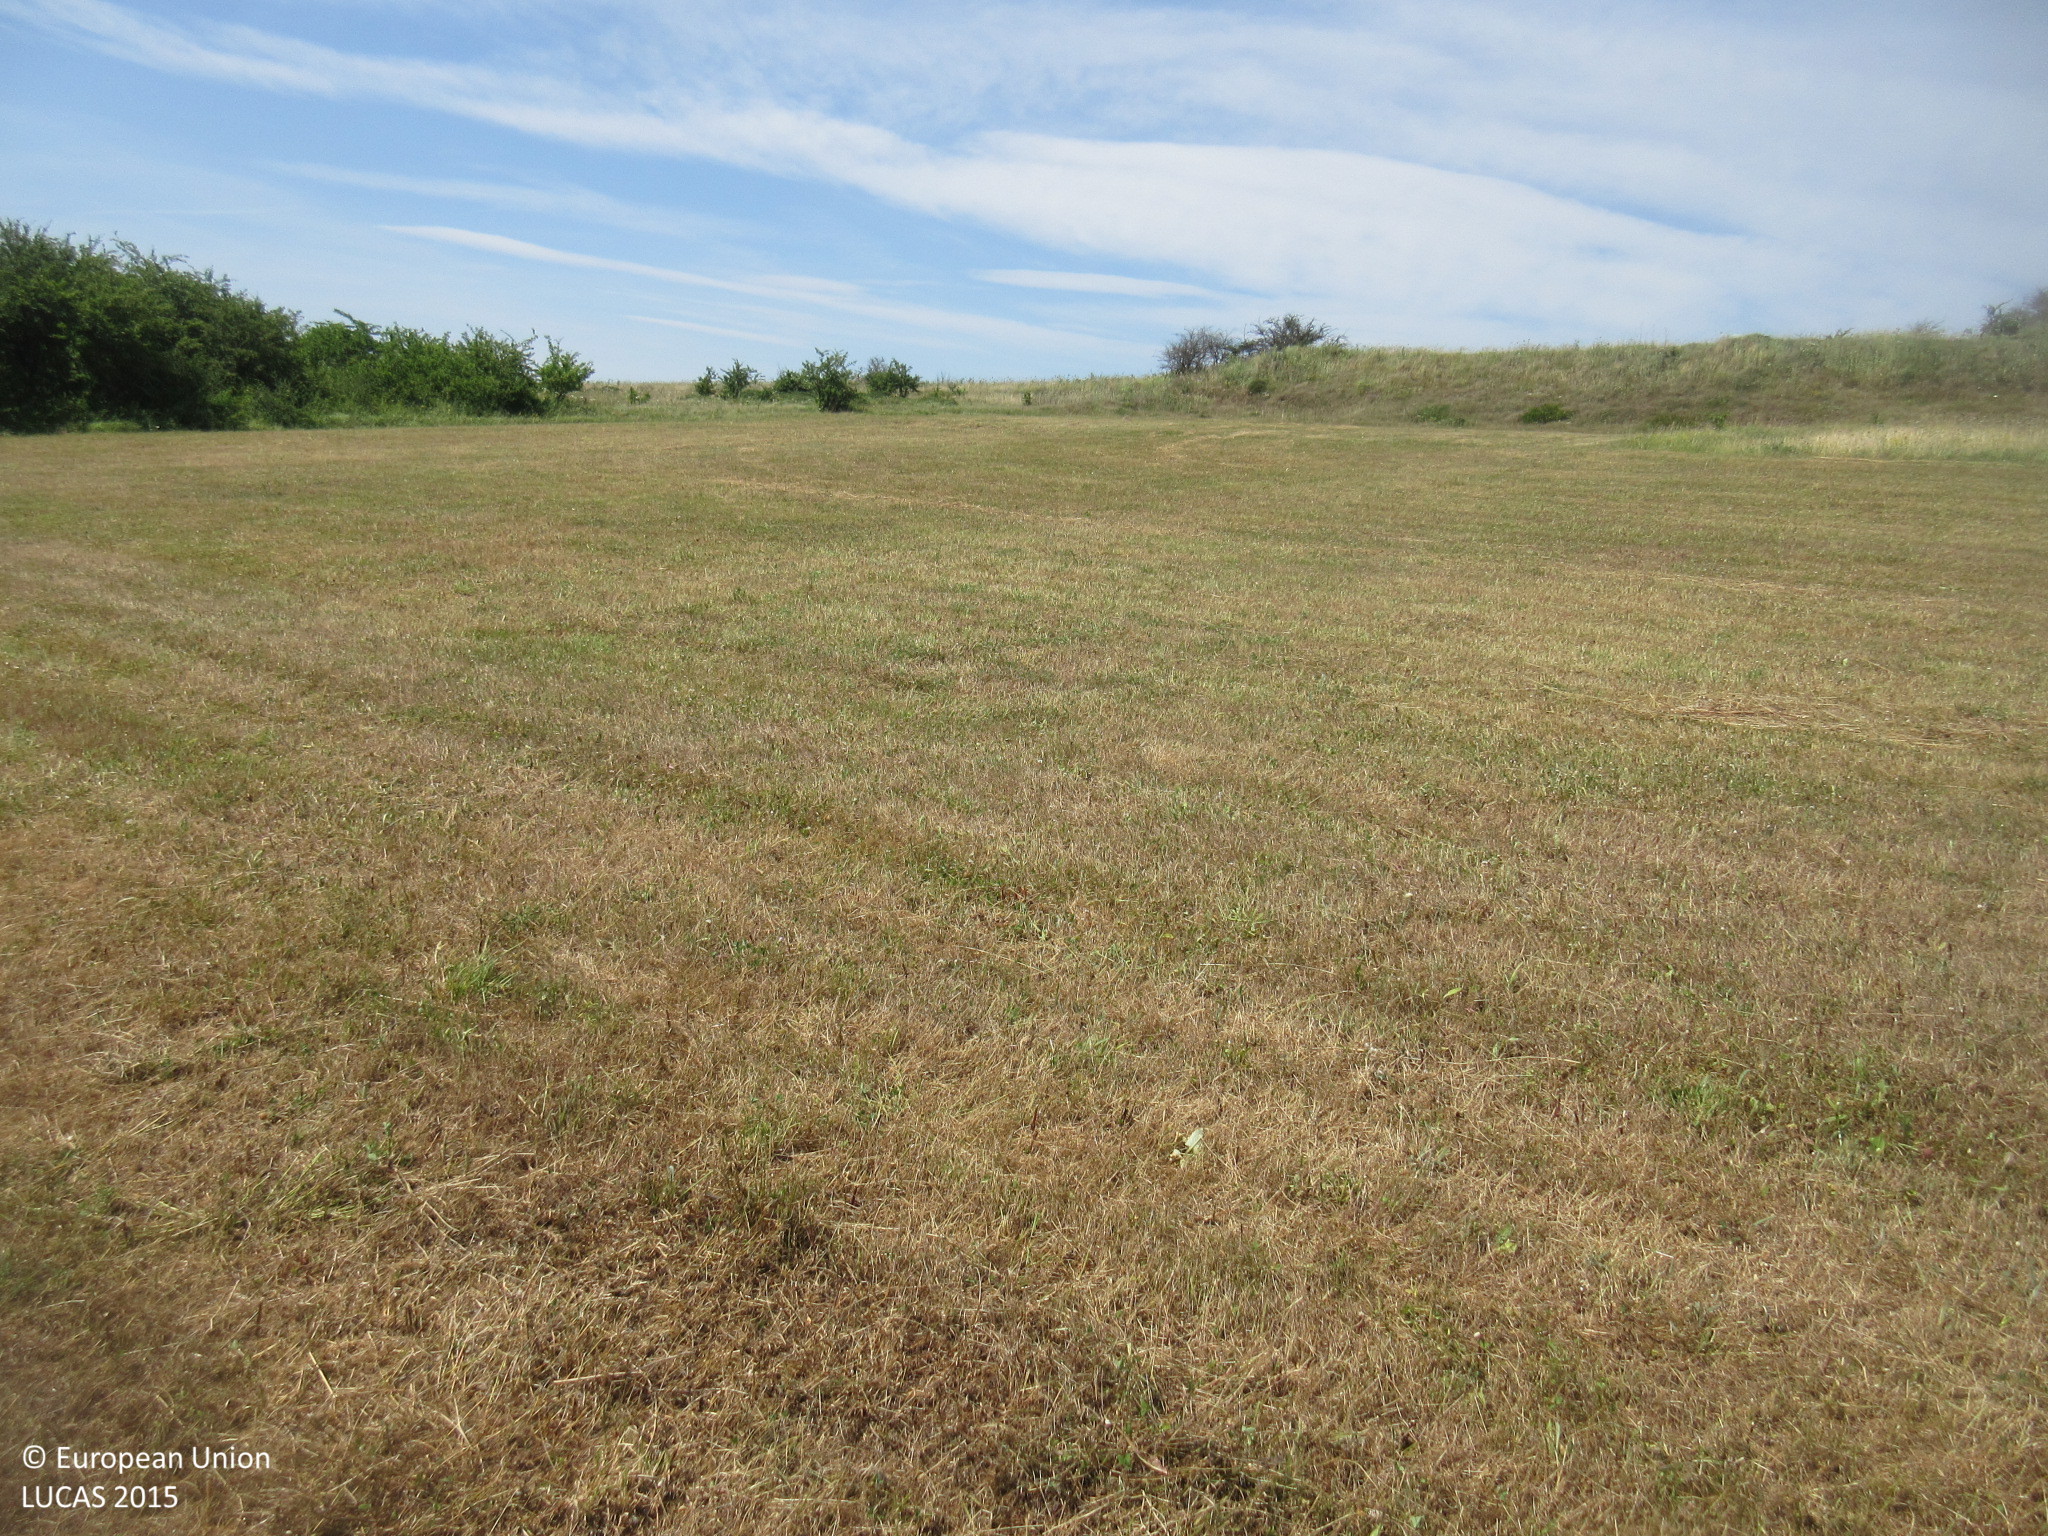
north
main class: Grassland
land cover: Grassland without tree/shrub cover
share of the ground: > 75 %
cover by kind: herbaceous plants 100 %
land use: Agriculture (excluding fallow land and kitchen gardens)
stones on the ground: 25 - 50 %
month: July
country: ES
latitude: 42.9725
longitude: -3.8887
